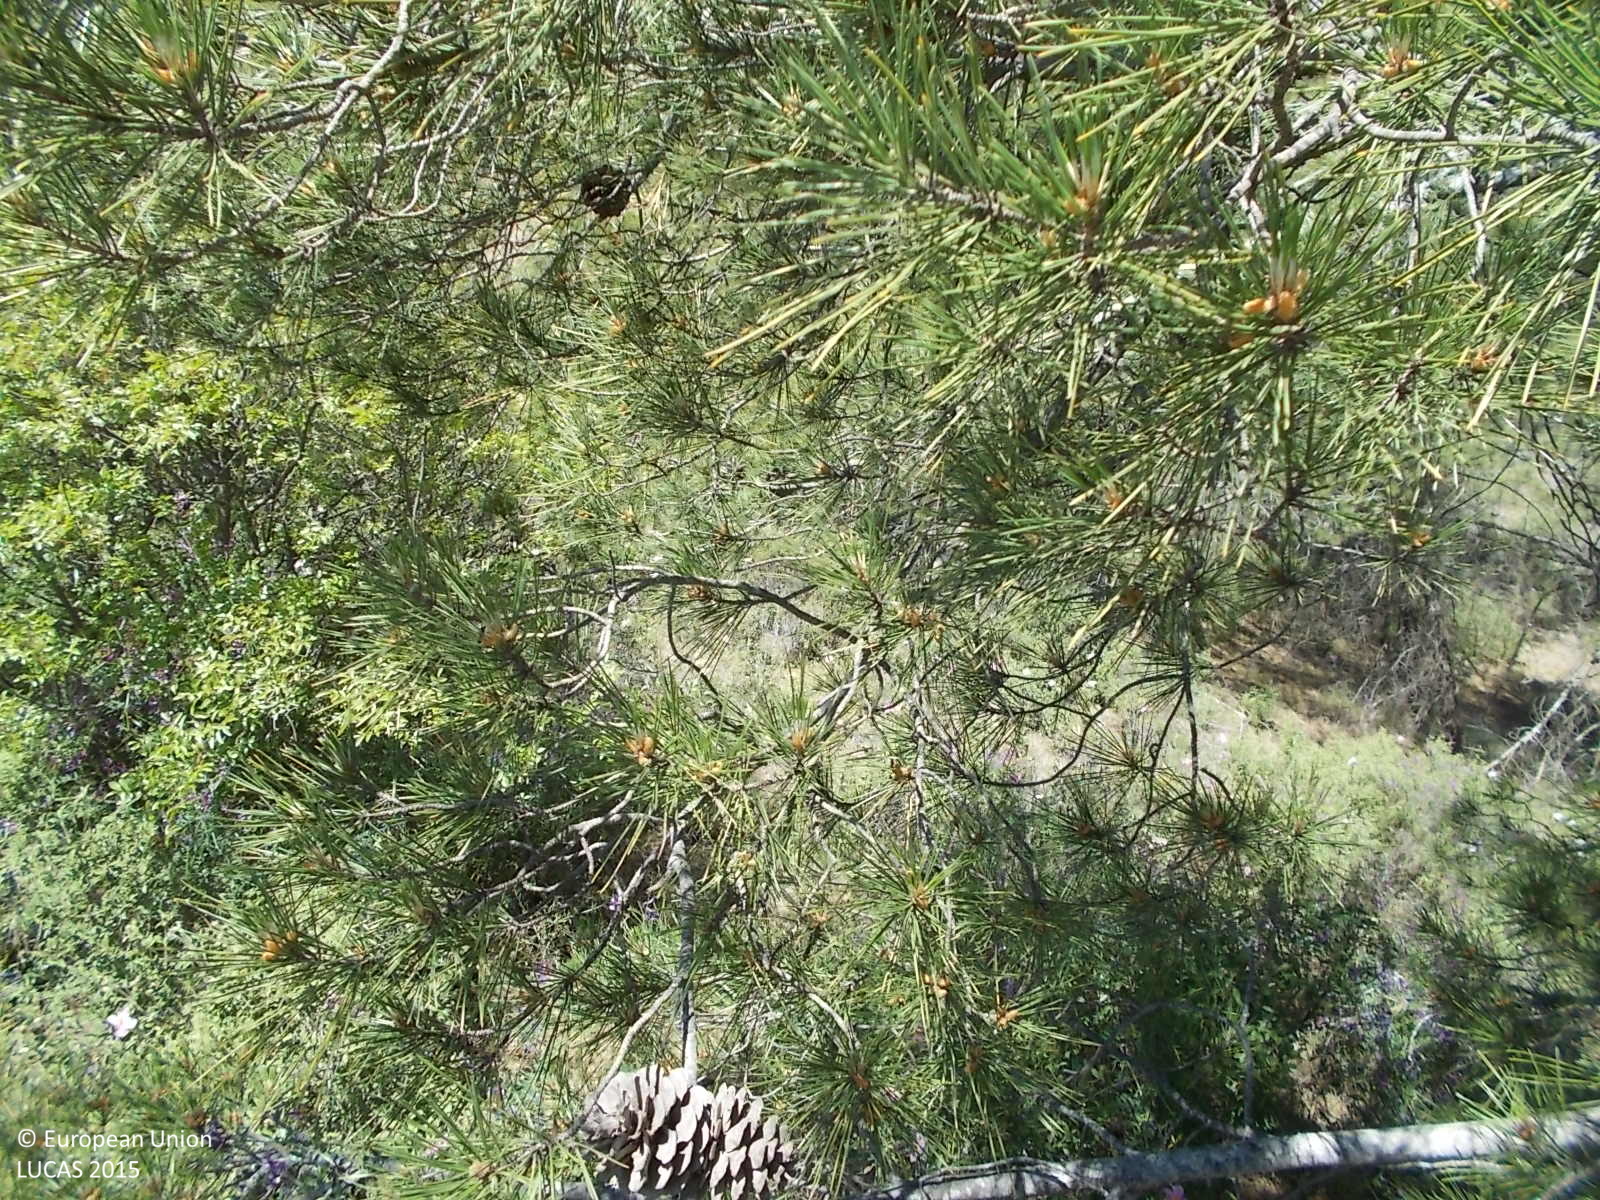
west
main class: Woodland
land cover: Pine dominated coniferous woodland
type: coniferous forest of the mediterranean region
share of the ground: > 75 %
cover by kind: coniferous forest trees 100 %
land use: Semi-natural and natural areas not in use
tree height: > 5 m
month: May
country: CY
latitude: 34.9741
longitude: 33.1023
